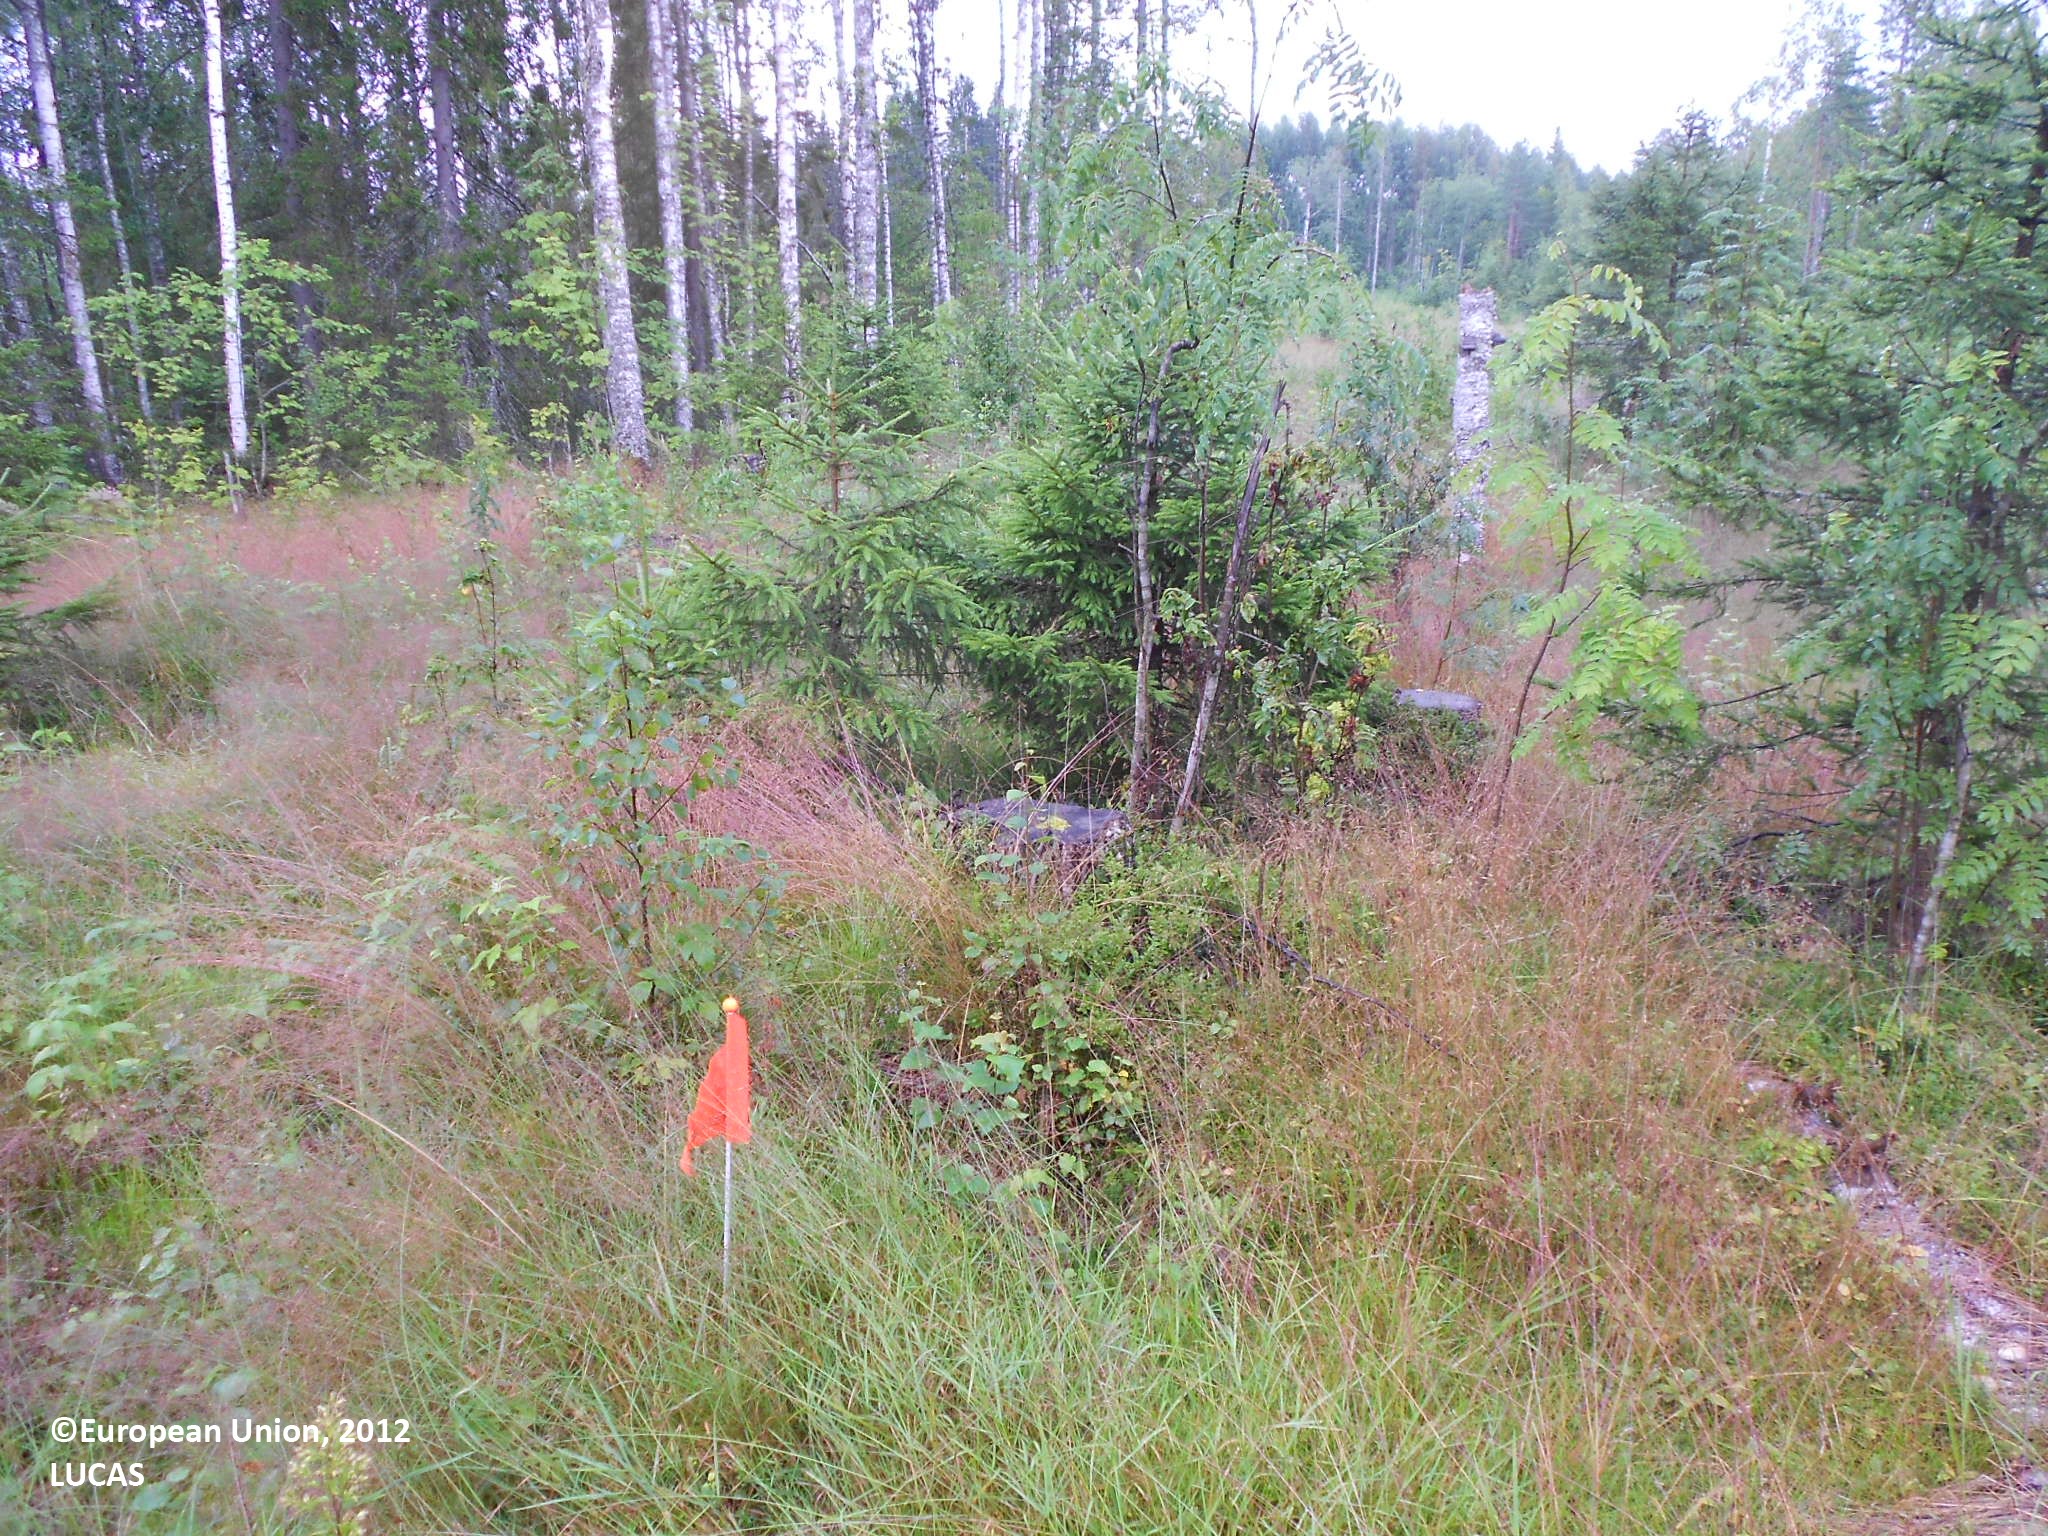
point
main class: Shrubland
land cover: Shrubland with sparse tree cover
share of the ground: > 75 %
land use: Forestry
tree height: < 5 m
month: August
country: FI
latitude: 63.4582
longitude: 28.3786
